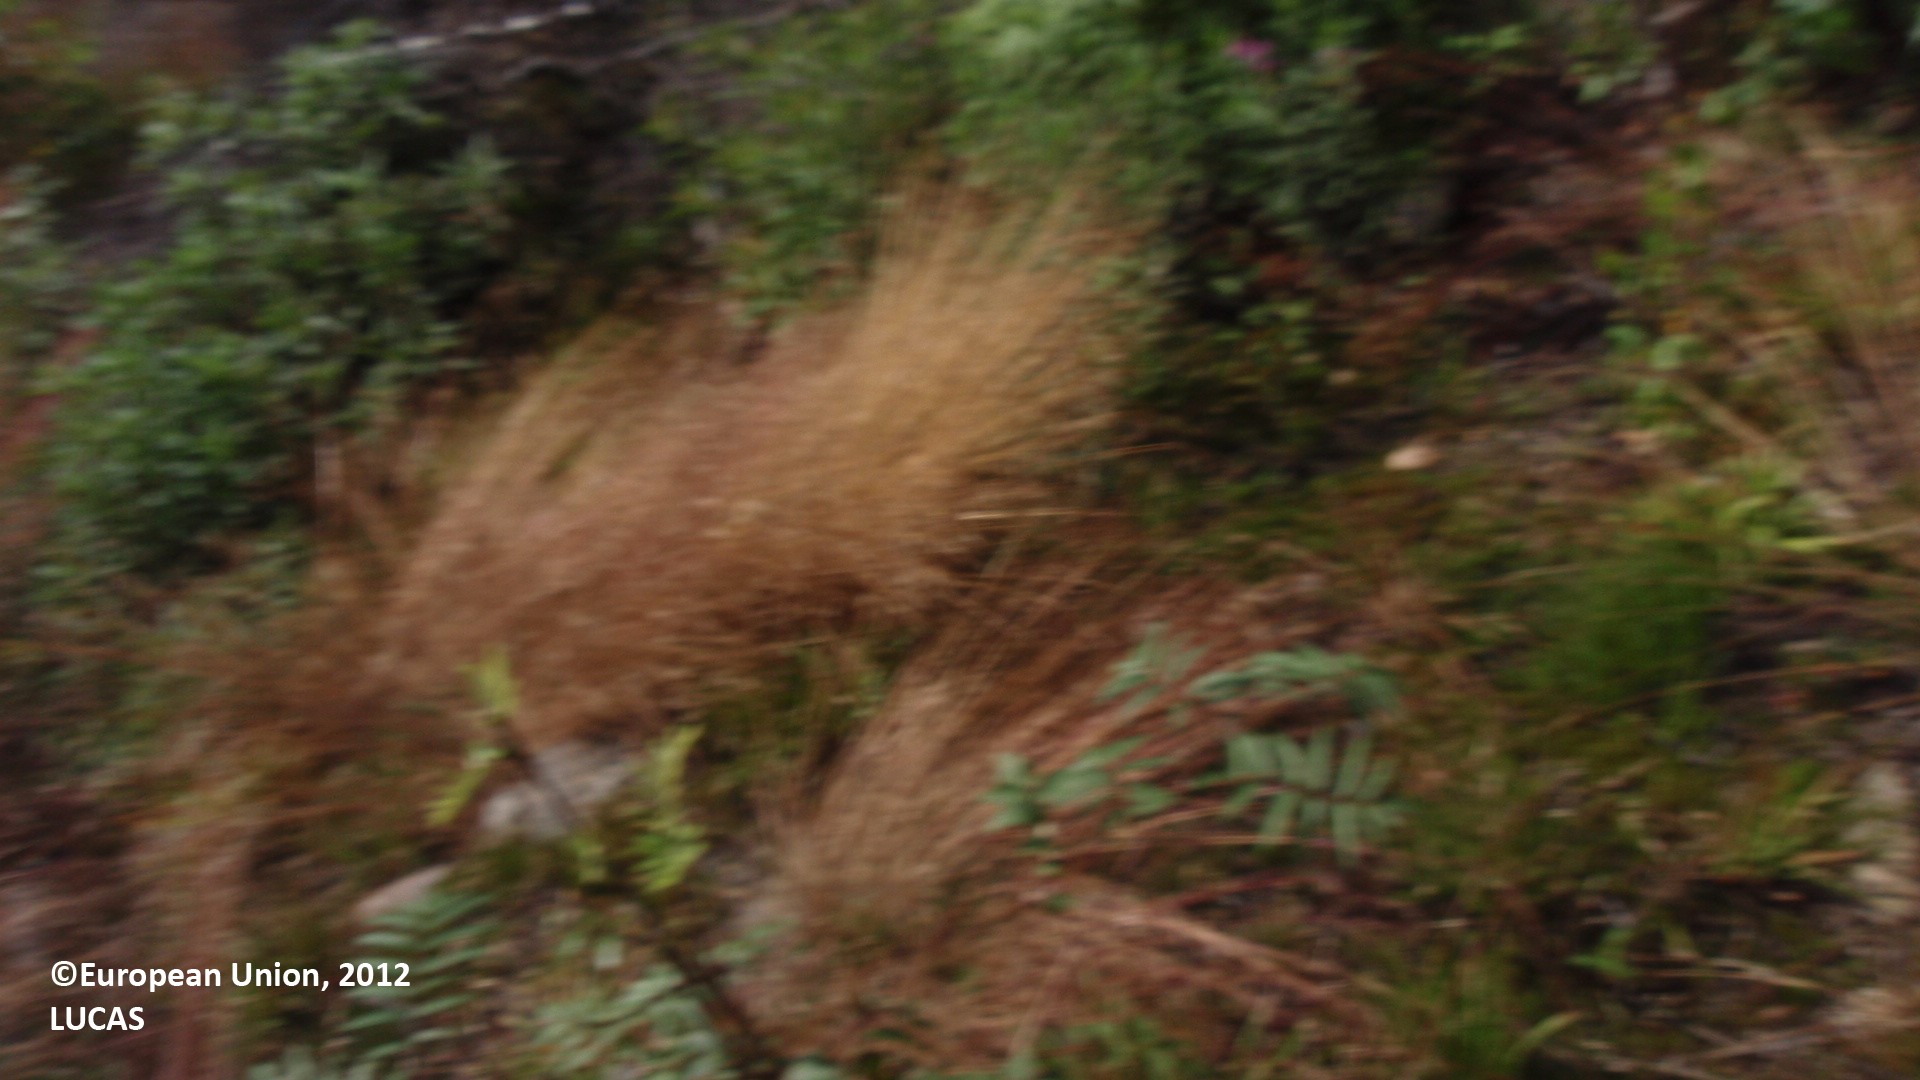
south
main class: Woodland
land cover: Spruce dominated mixed woodland
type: boreal forest
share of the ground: 10 - 25 %
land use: Forestry
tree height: < 5 m
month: July
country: FI
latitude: 61.4723
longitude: 28.7474
